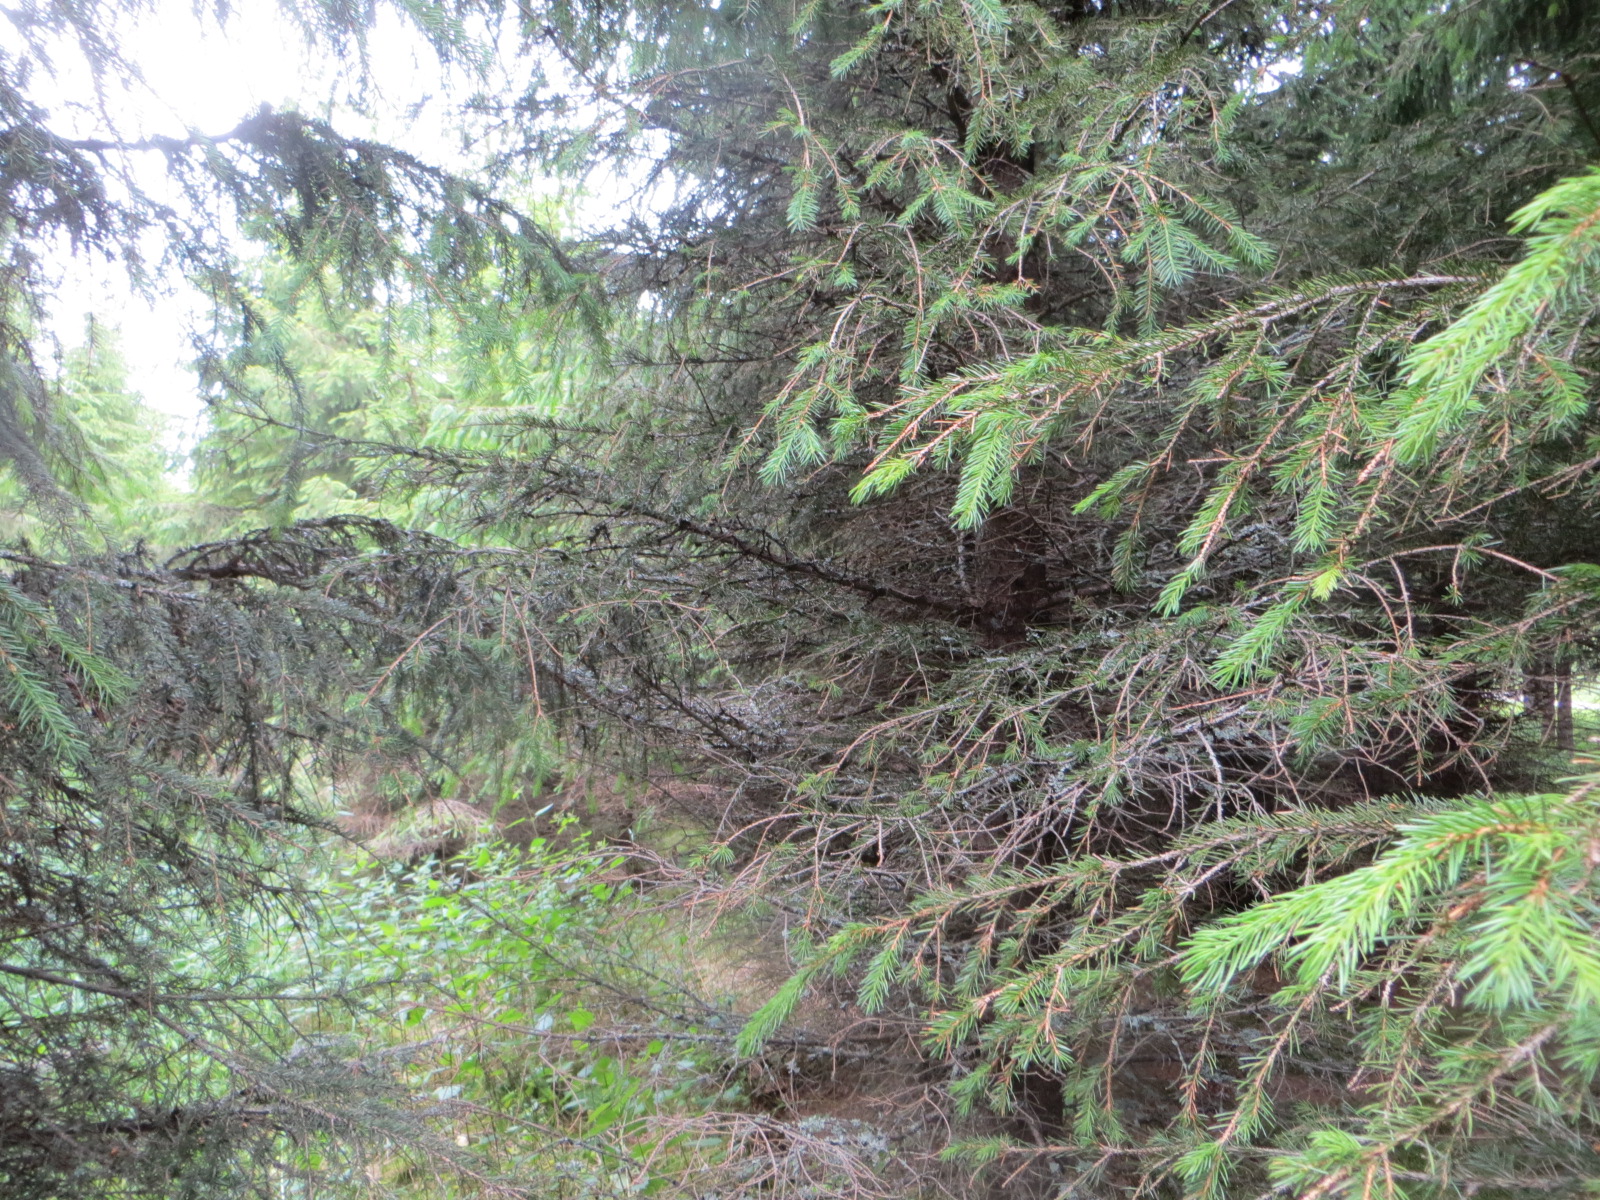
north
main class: Woodland
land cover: Spruce dominated coniferous woodland
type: boreal forest
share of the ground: > 75 %
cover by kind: coniferous forest trees 90 %, shrubs 10 %
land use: Forestry
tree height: > 5 m
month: July
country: FI
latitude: 65.7769
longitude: 25.2938
